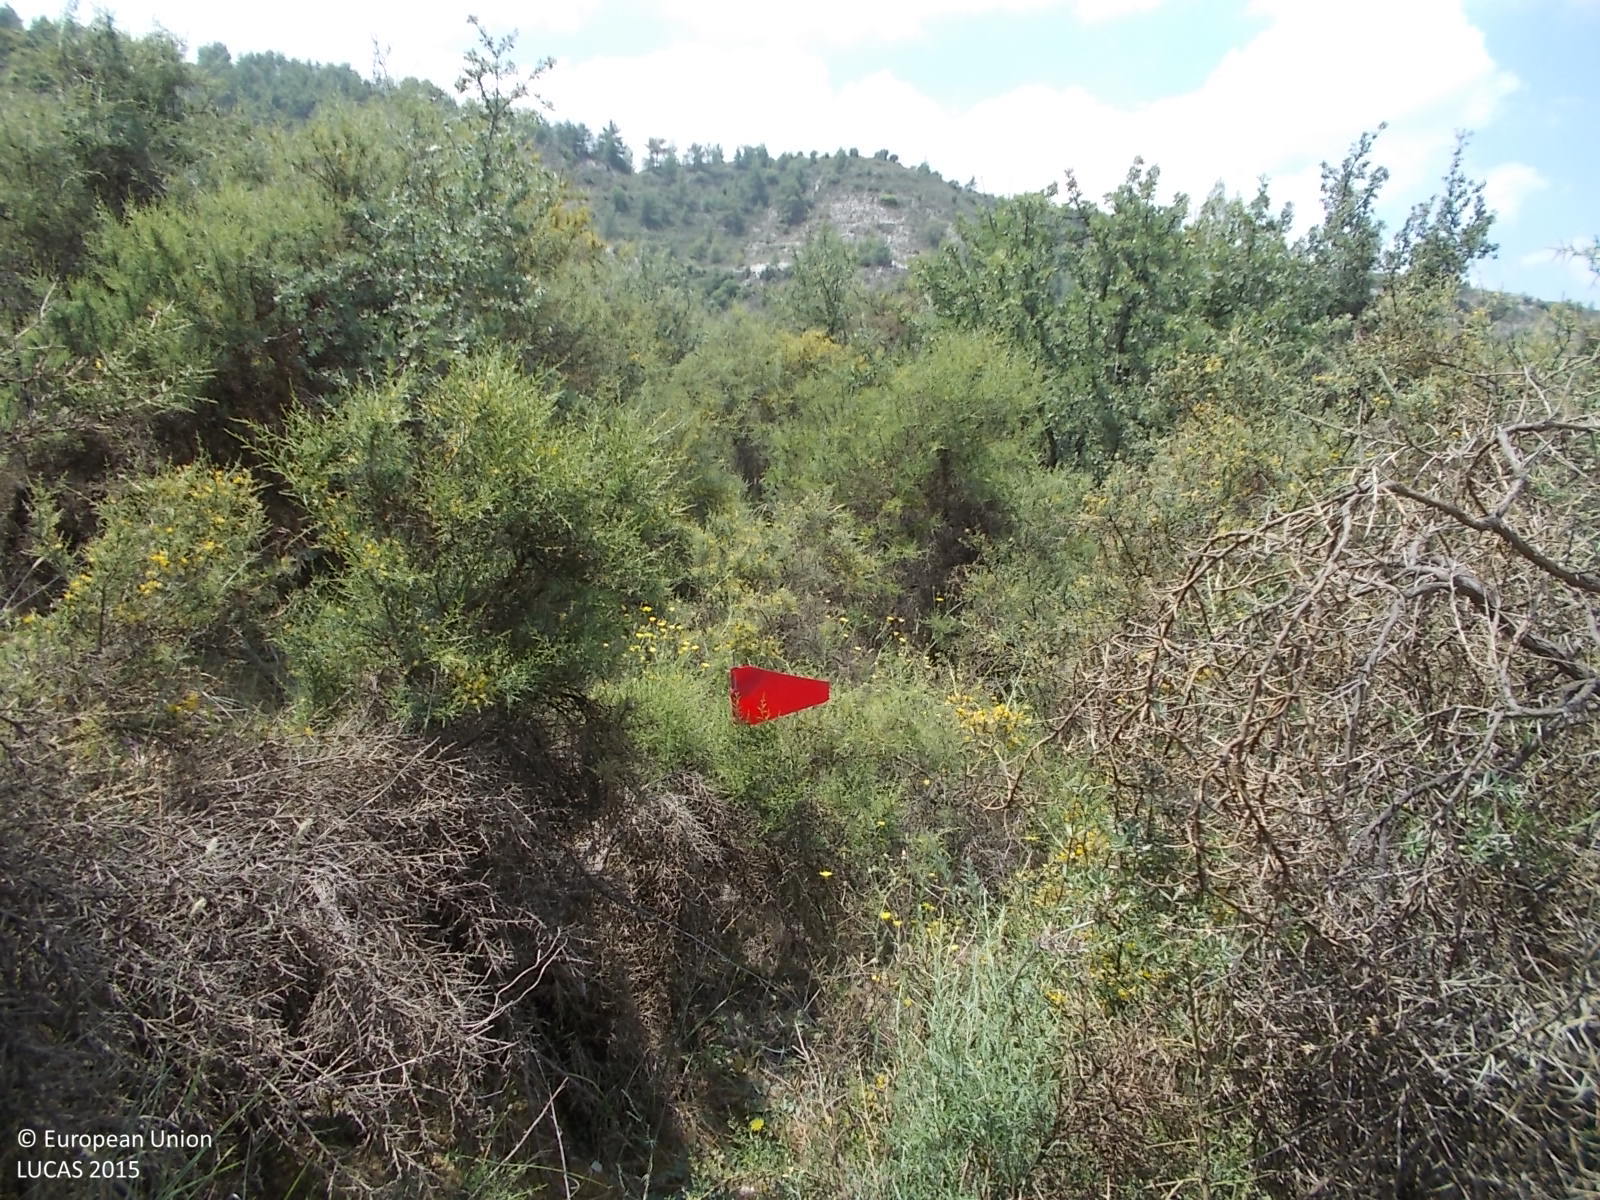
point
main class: Shrubland
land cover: Shrubland with sparse tree cover
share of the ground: > 75 %
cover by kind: shrubs 85 %, unconsolidated bare surface 10 %, broadleaved forest trees 5 %
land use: Semi-natural and natural areas not in use
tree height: > 5 m
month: June
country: CY
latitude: 34.8758
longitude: 32.7518
